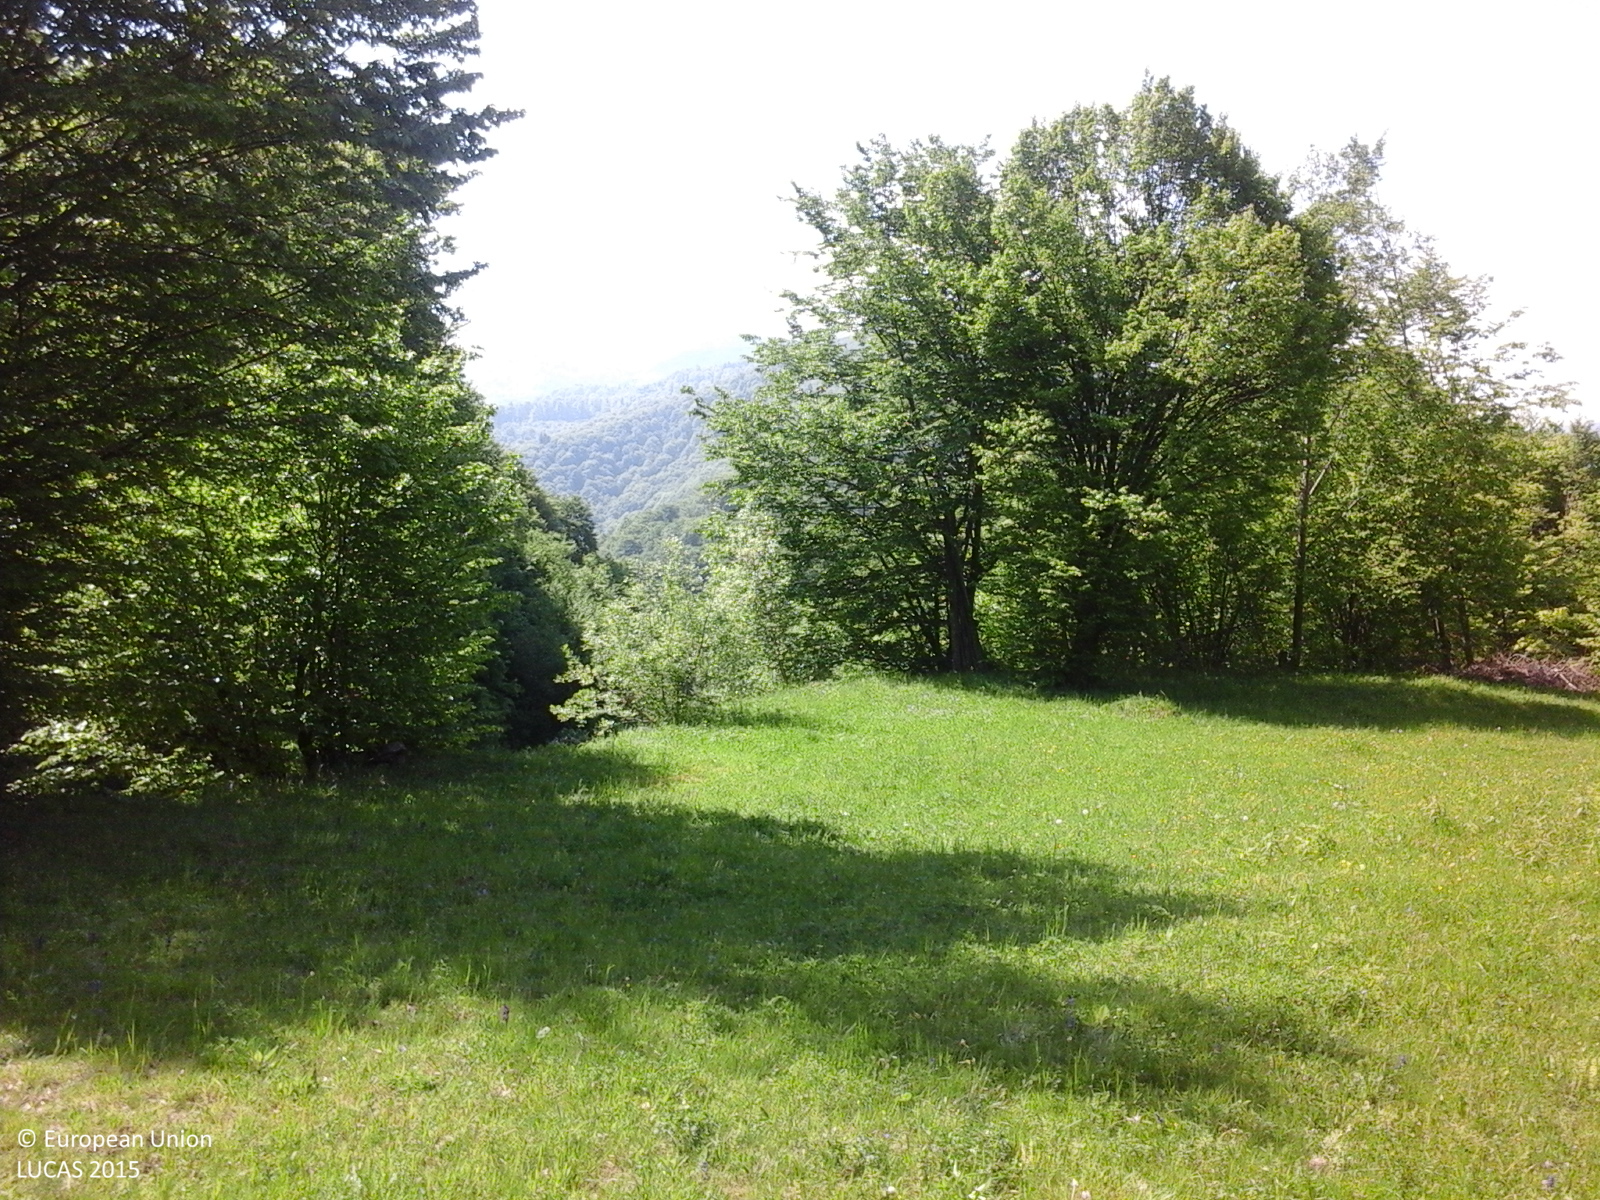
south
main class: Grassland
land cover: Grassland without tree/shrub cover
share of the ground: > 75 %
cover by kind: herbaceous plants 100 %
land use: Agriculture (excluding fallow land and kitchen gardens)
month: May
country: RO
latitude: 45.5904
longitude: 26.1529
